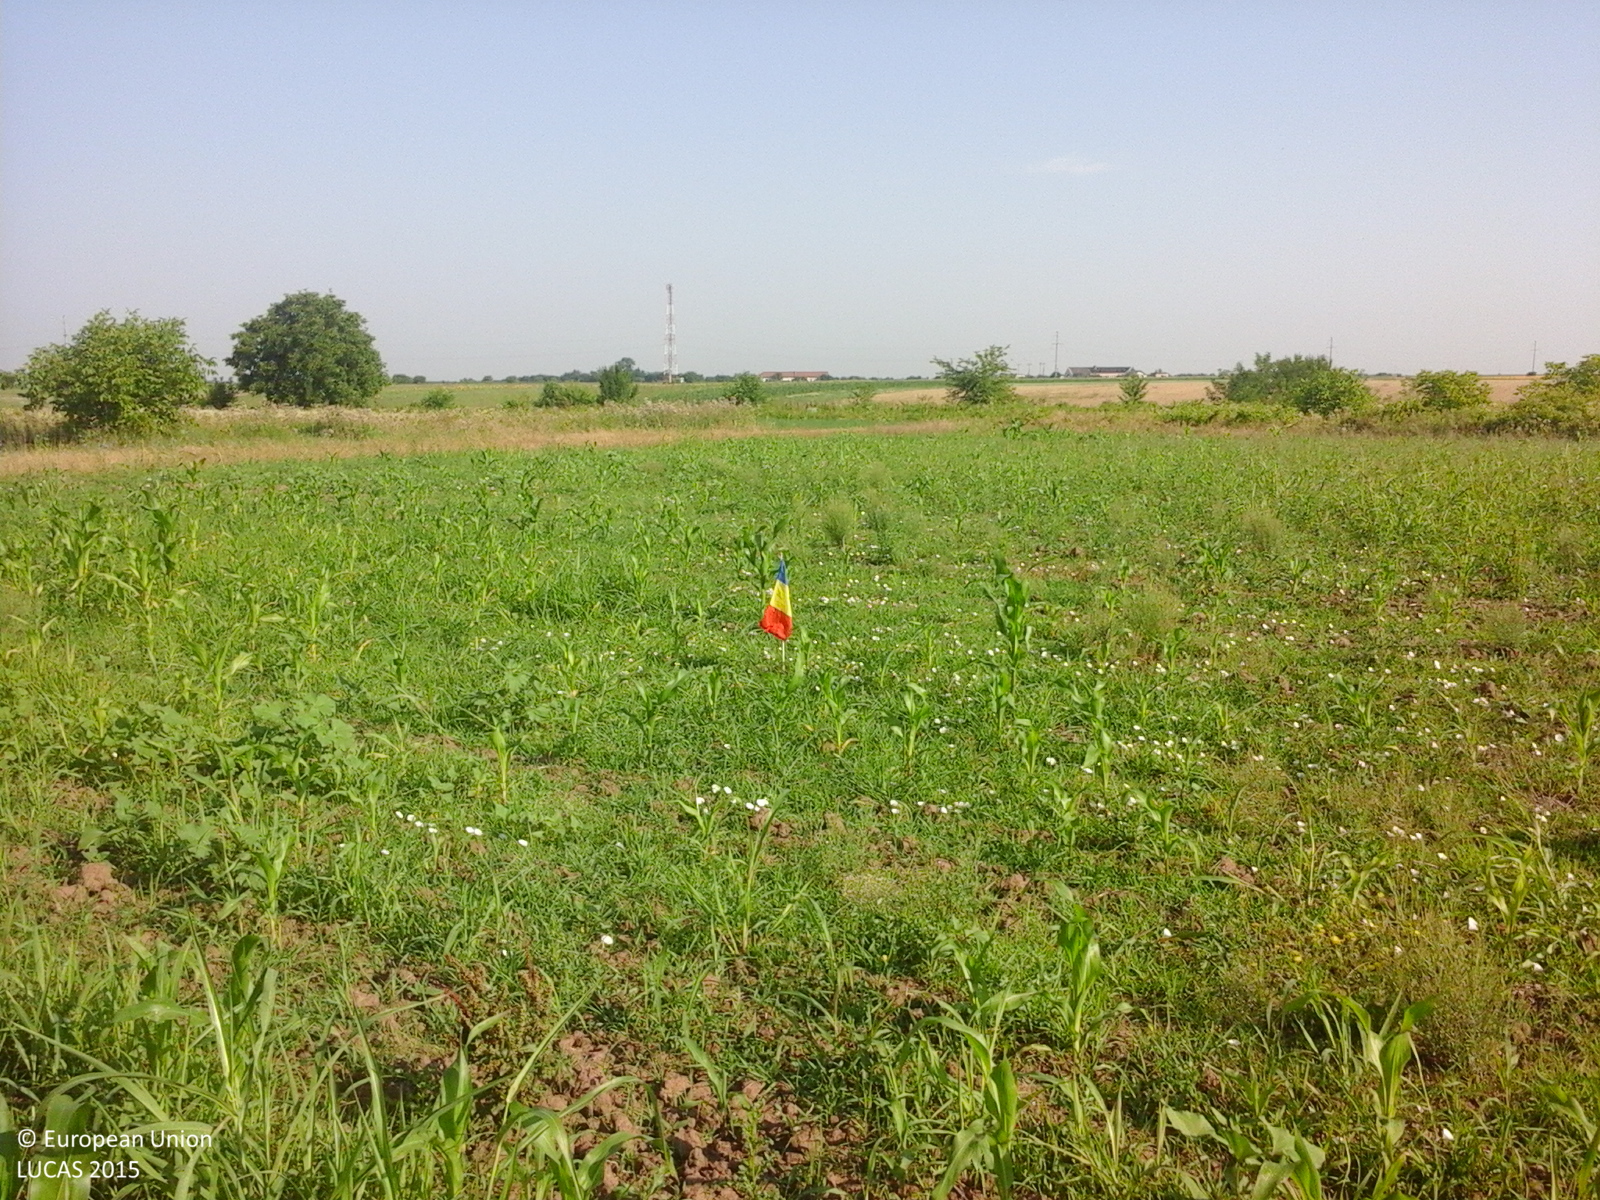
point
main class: Cropland
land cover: Maize
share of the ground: 25 - 50 %
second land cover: Spontaneously vegetated surfaces
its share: 50 - 75 %
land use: Agriculture (excluding fallow land and kitchen gardens)
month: July
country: RO
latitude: 44.1182
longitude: 25.3419
